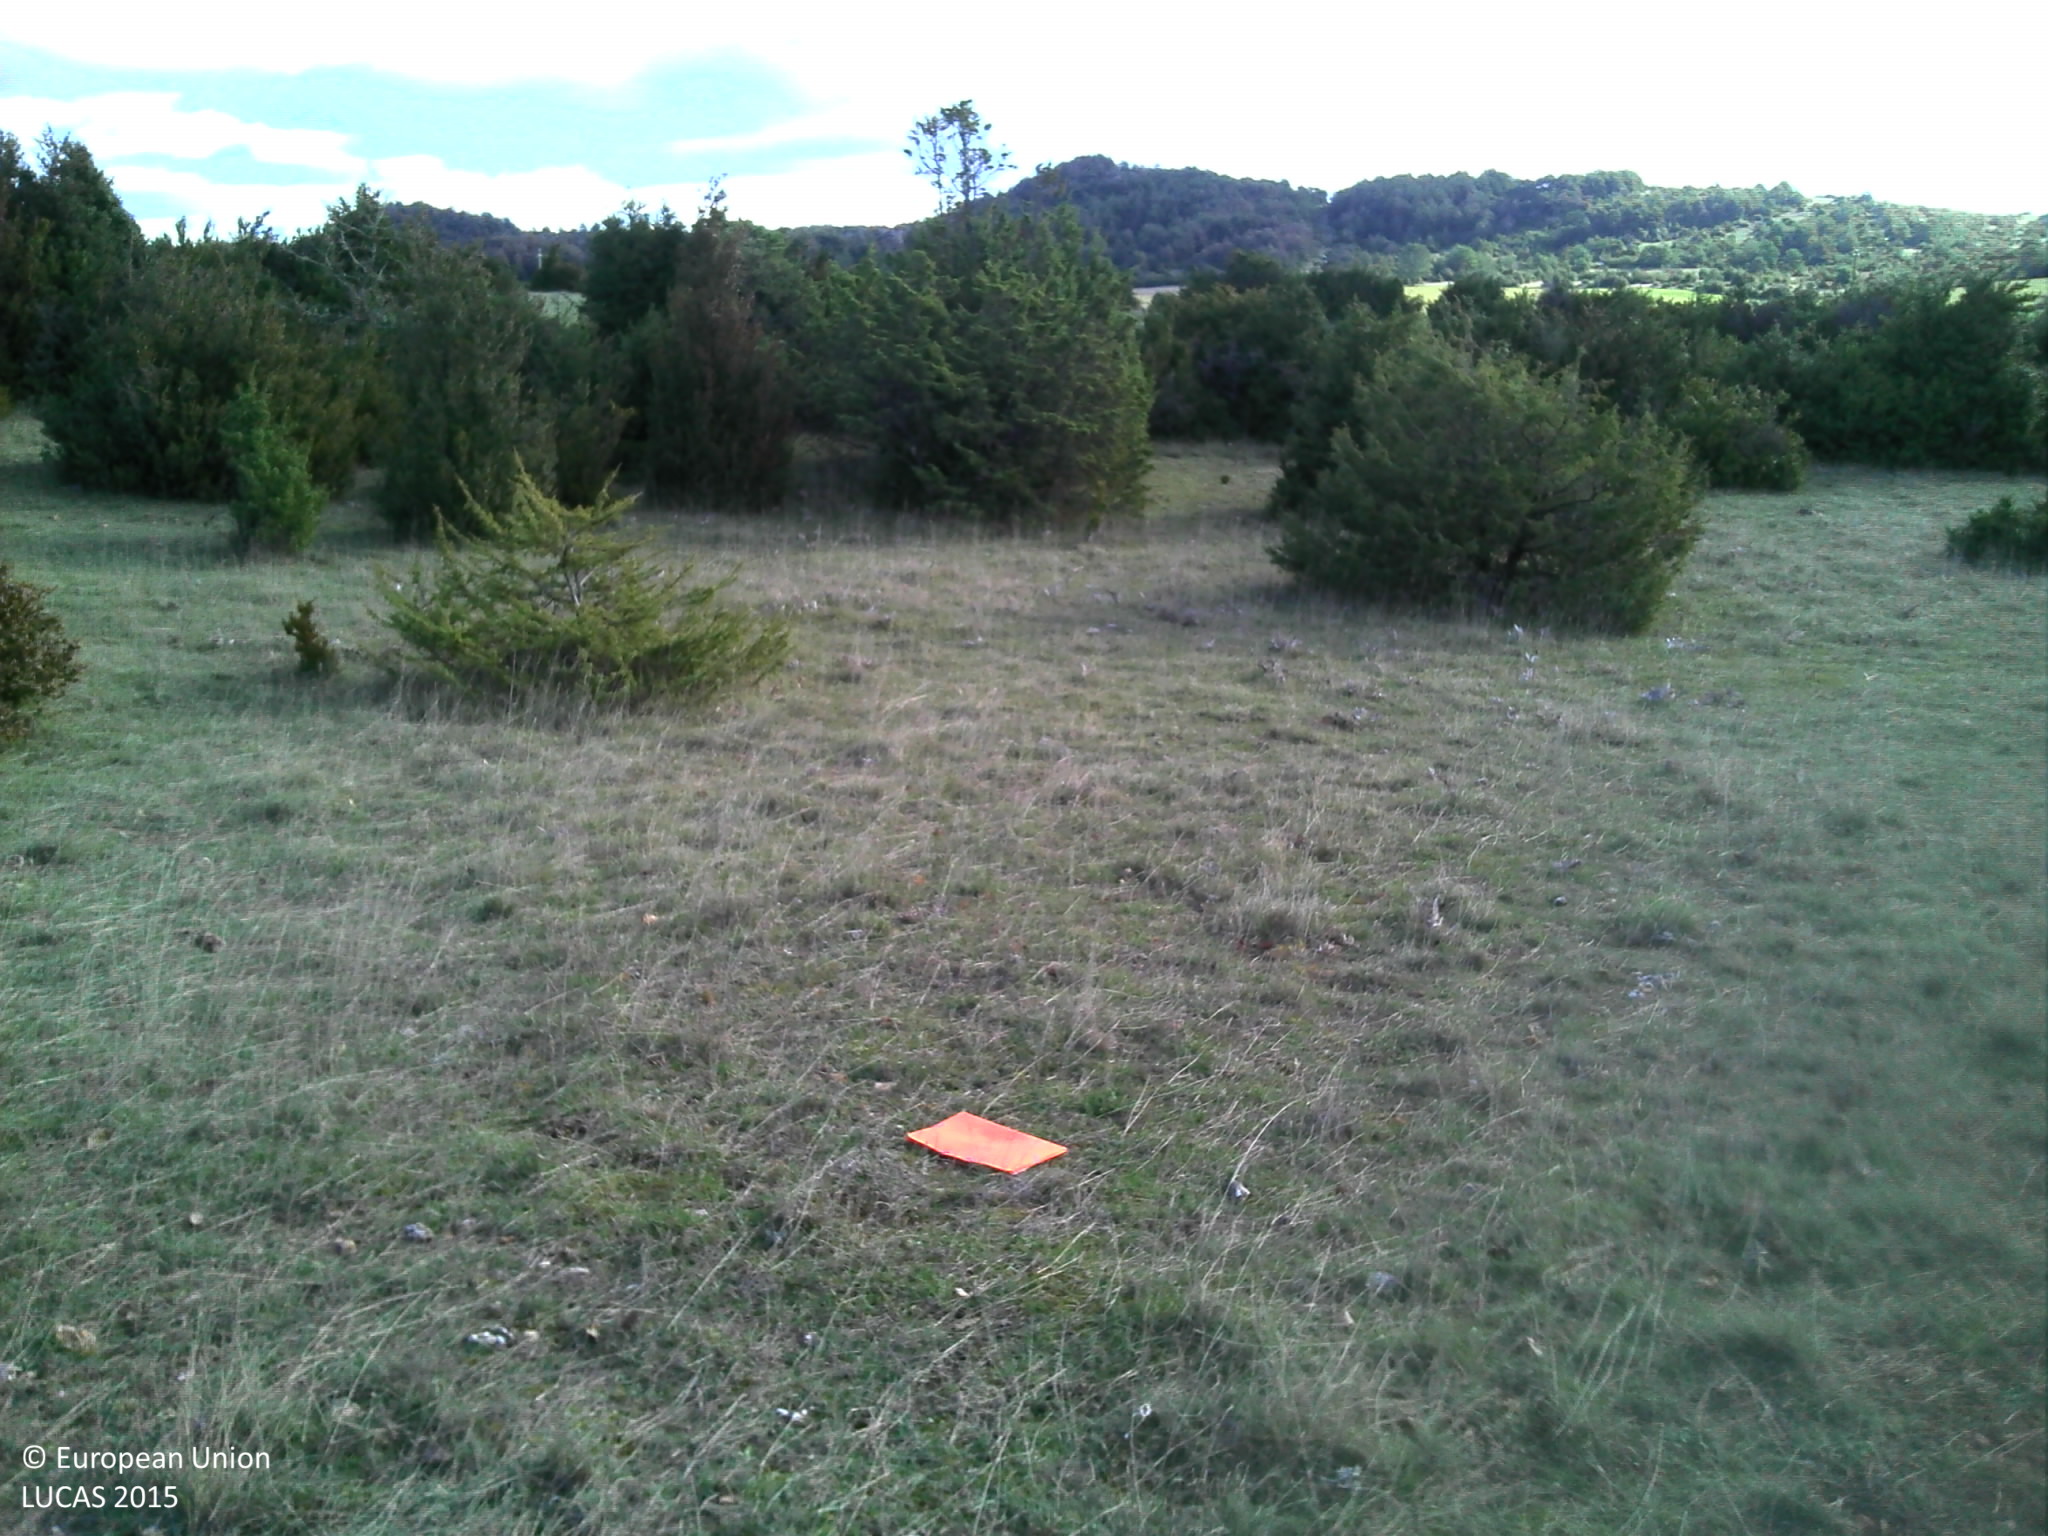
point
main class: Grassland
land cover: Grassland with sparse tree/shrub cover
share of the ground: > 75 %
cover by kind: herbaceous plants 90 %, coniferous forest trees 5 %, shrubs 5 %
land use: Agriculture (excluding fallow land and kitchen gardens)
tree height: < 5 m
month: November
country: FR
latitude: 43.9148
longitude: 3.2700
